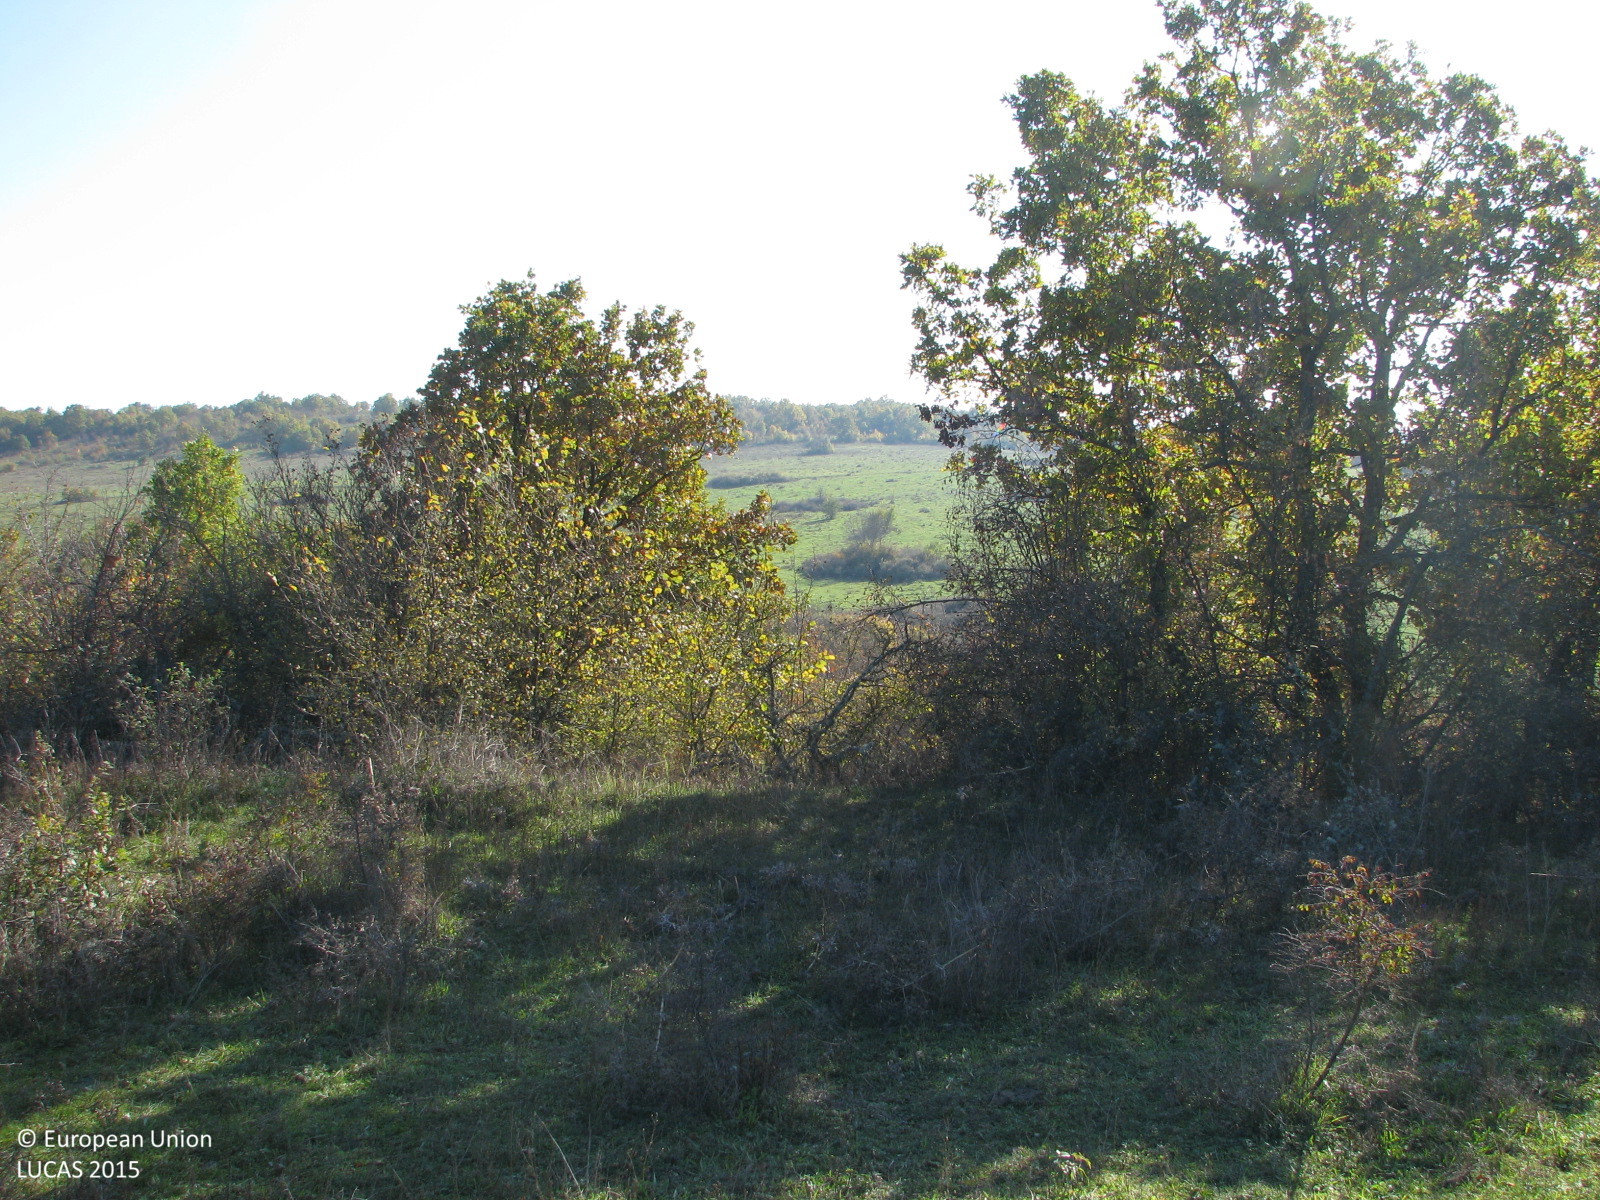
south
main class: Grassland
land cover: Grassland with sparse tree/shrub cover
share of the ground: > 75 %
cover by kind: herbaceous plants 90 %, broadleaved forest trees 5 %, shrubs 5 %
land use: Agriculture (excluding fallow land and kitchen gardens)
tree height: < 5 m
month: November
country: BG
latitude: 42.0564
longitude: 26.7556
